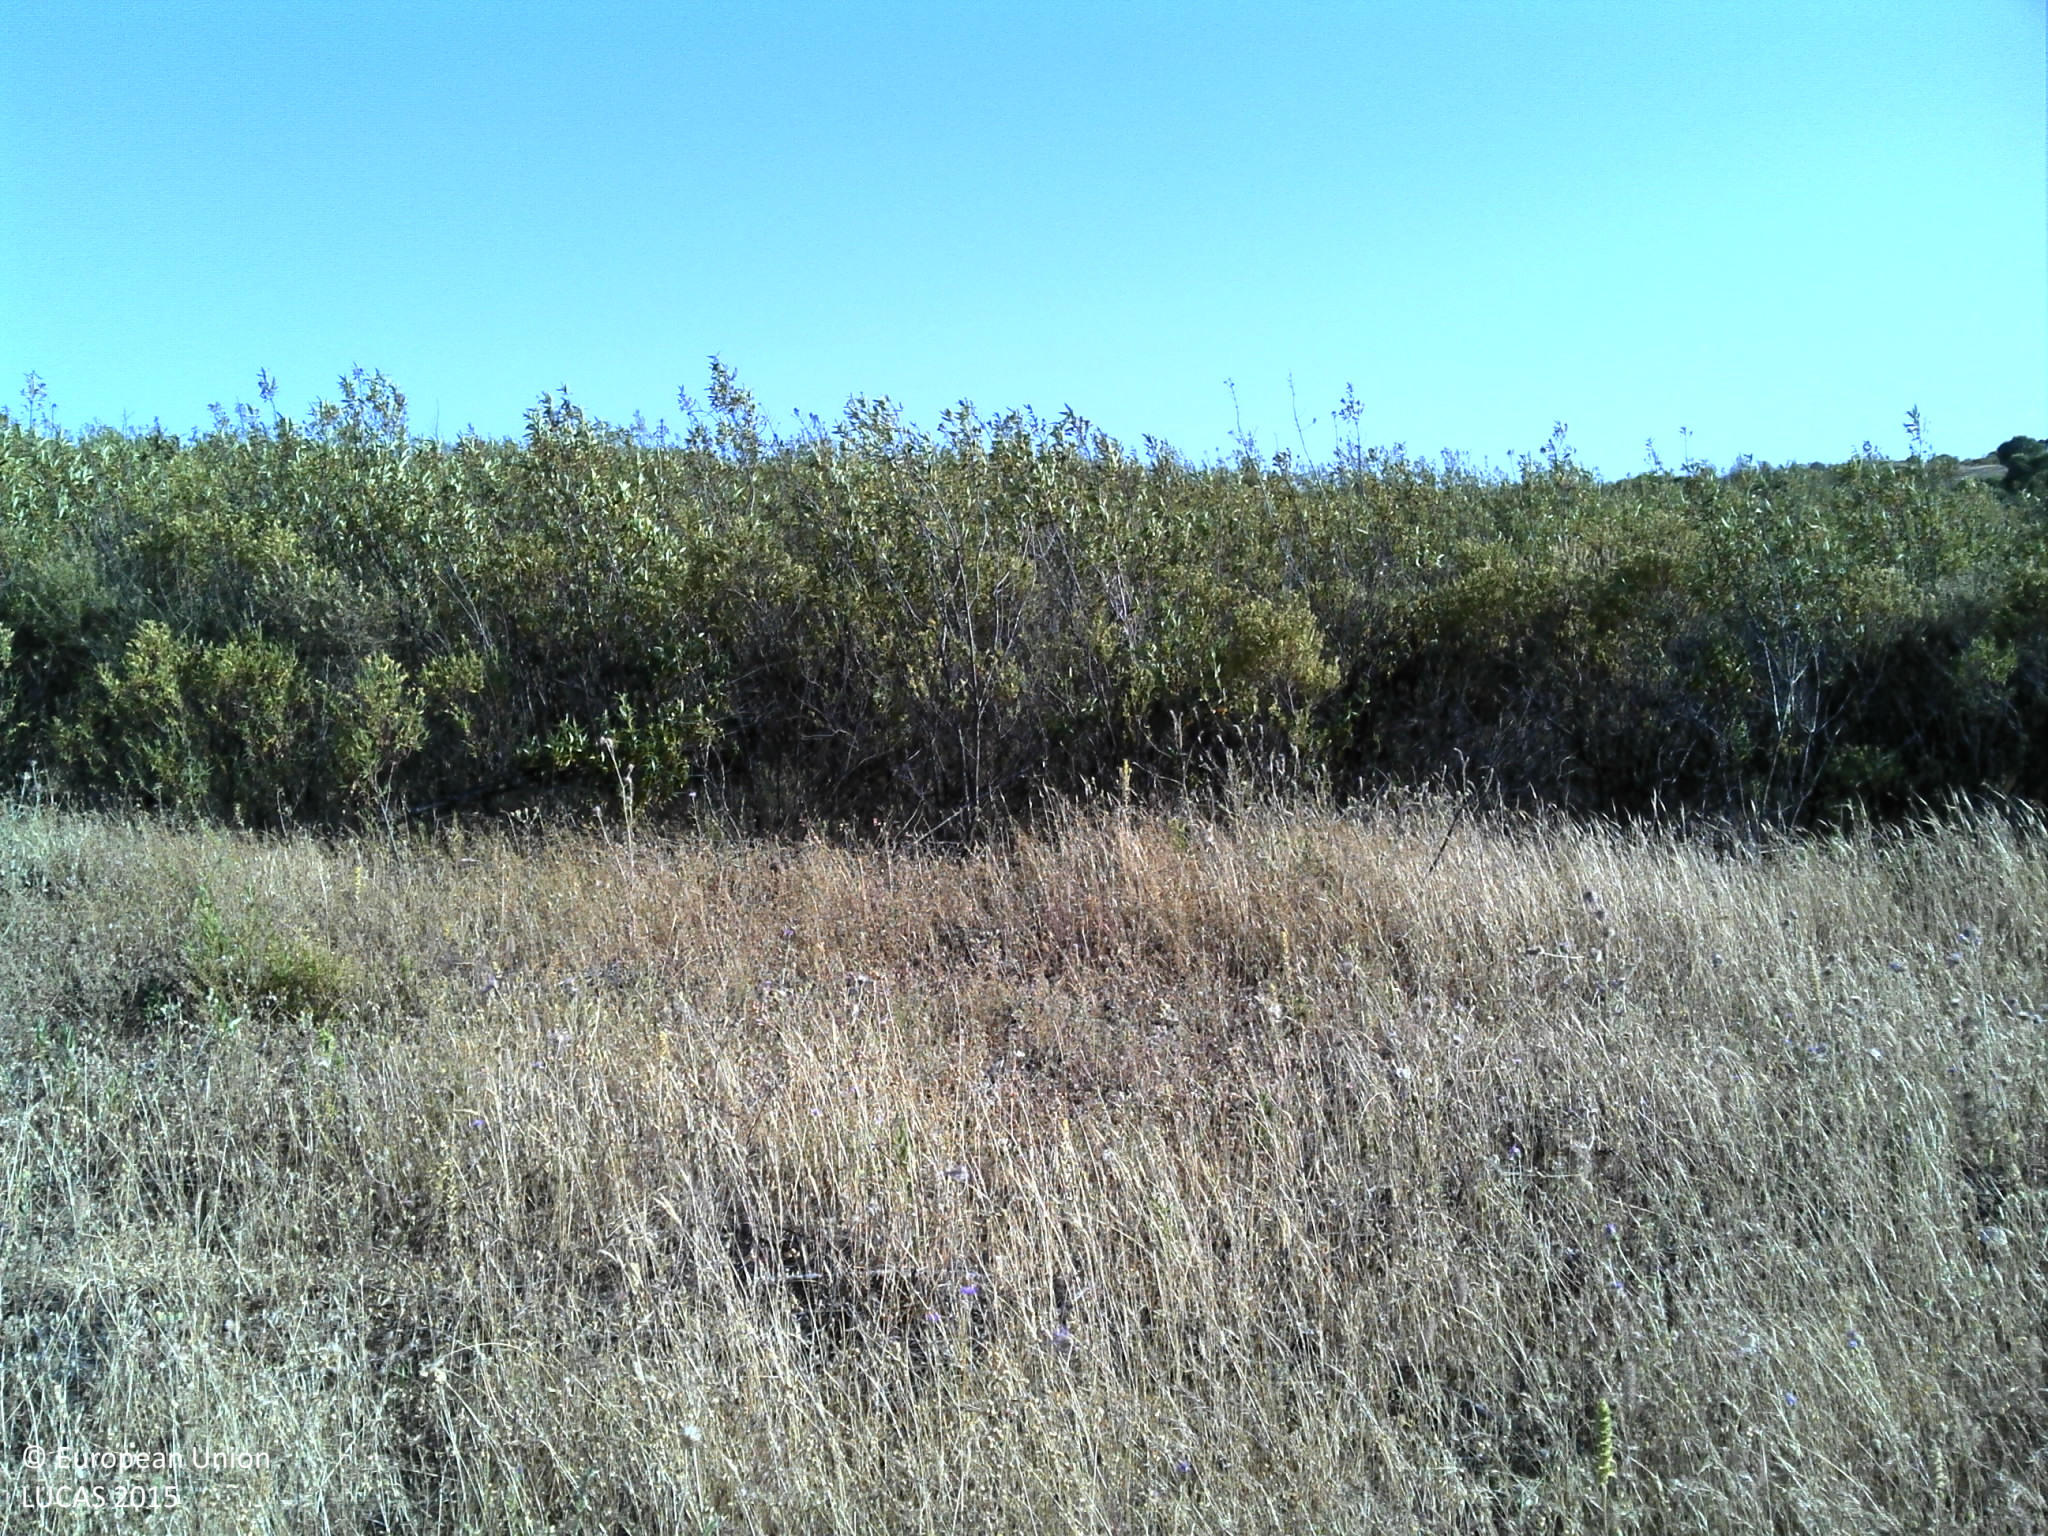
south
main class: Grassland
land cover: Grassland without tree/shrub cover
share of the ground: > 75 %
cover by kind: herbaceous plants 85 %, unconsolidated bare surface 15 %
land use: Agriculture (excluding fallow land and kitchen gardens)
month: May
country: PT
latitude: 37.5414
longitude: -7.5653
